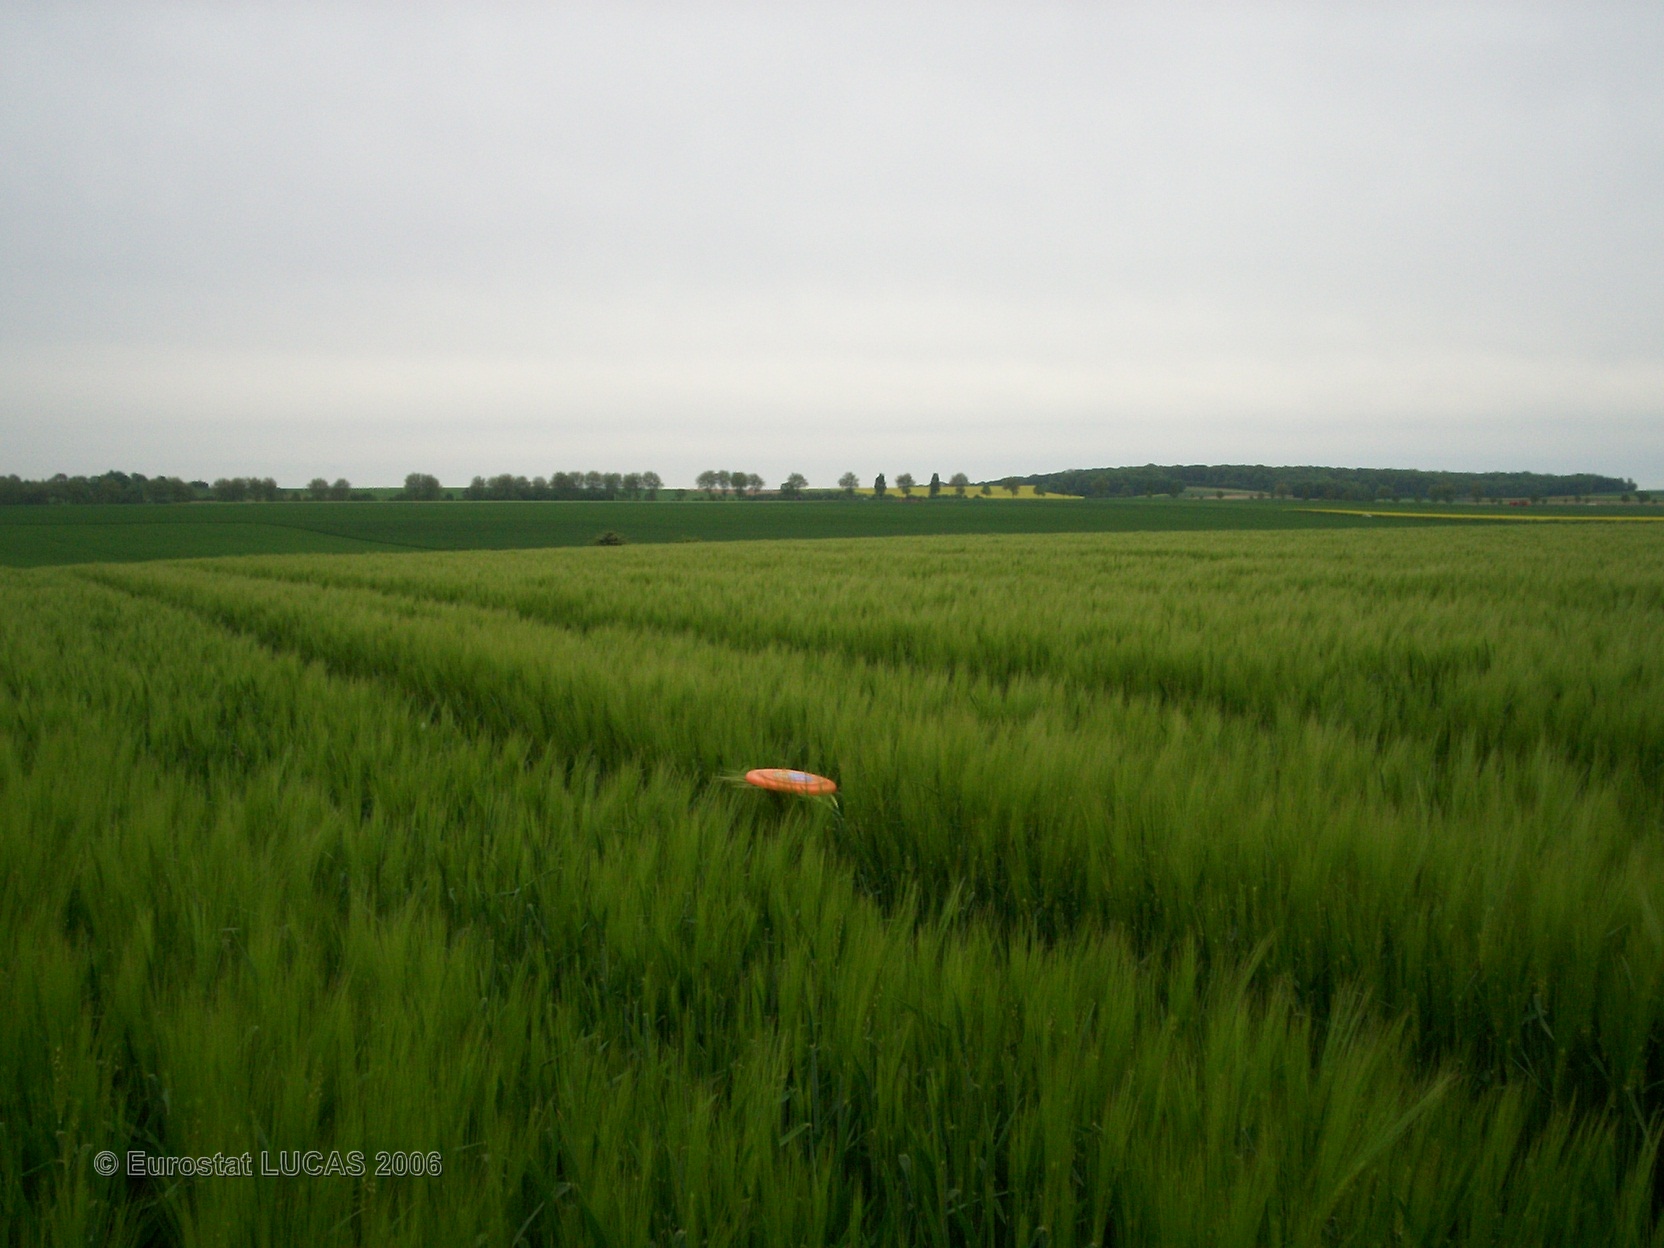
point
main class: Cropland
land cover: Barley
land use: Agriculture (excluding fallow land and kitchen gardens)
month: May
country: FR
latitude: 50.3434
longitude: 2.6391
